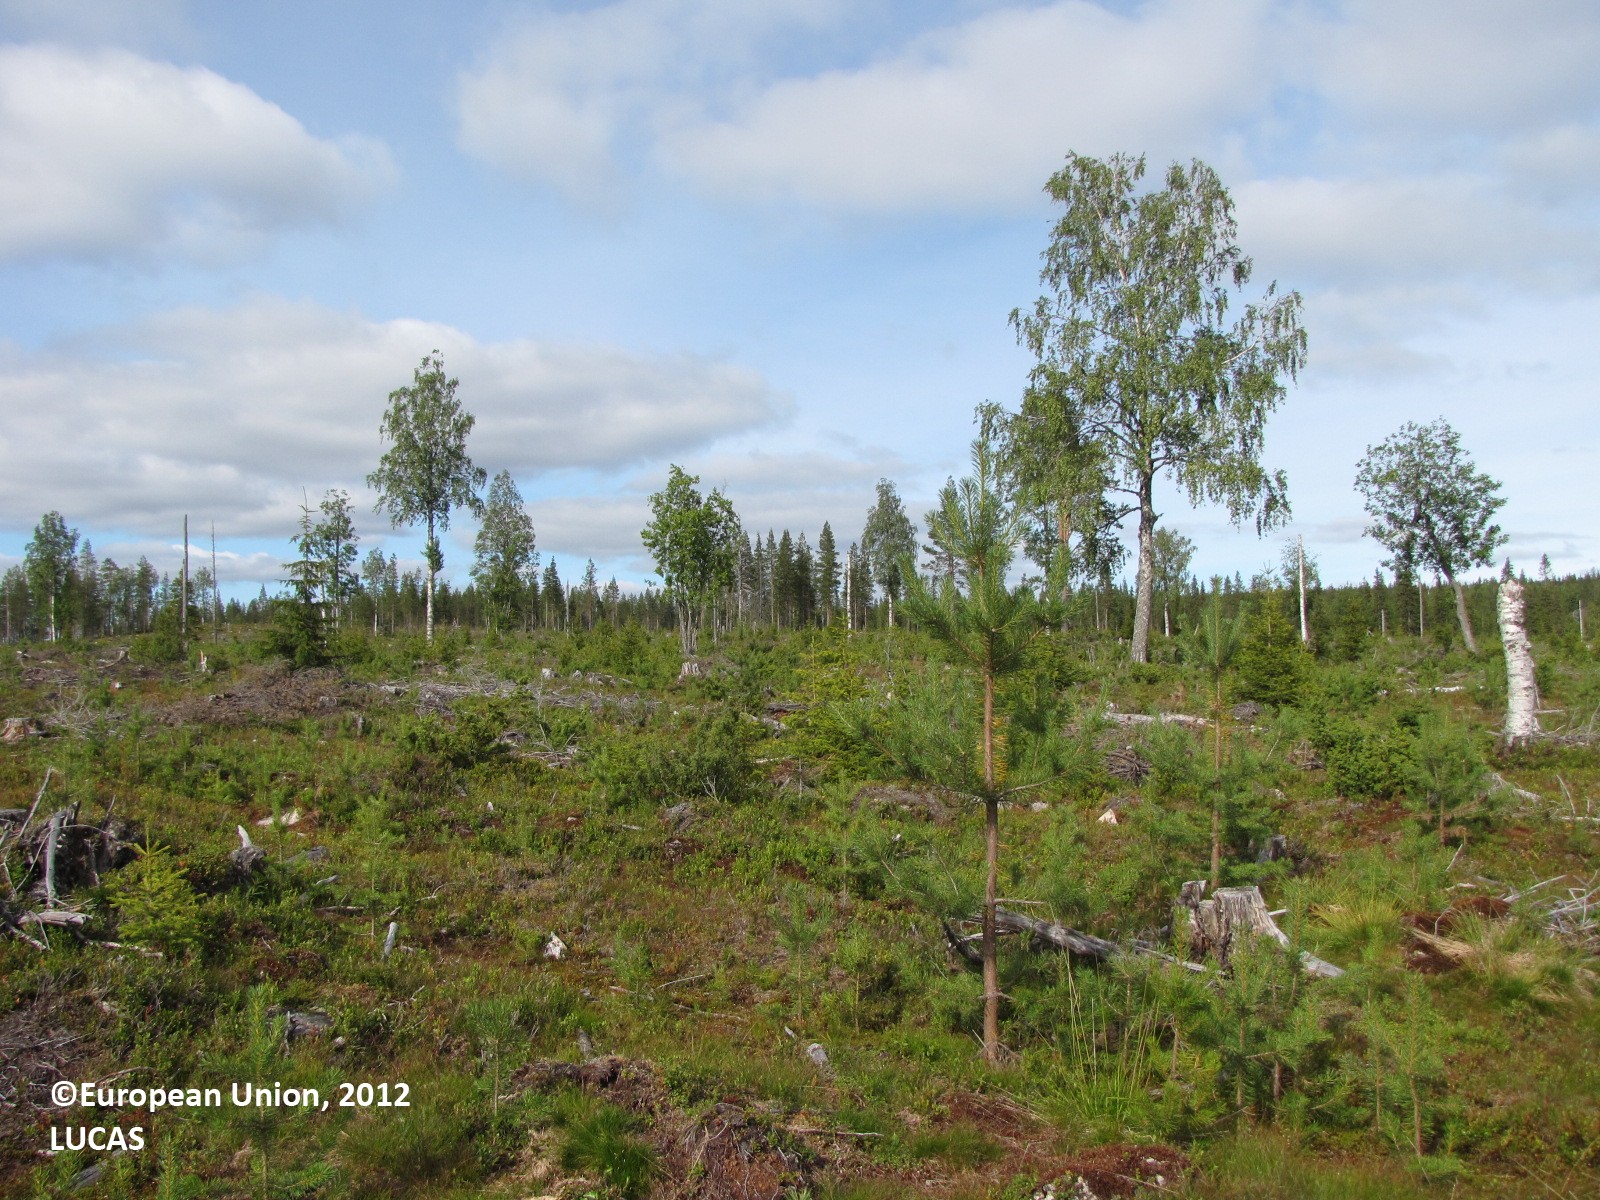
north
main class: Woodland
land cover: Pine dominated mixed woodland
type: boreal forest
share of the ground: 10 - 25 %
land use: Forestry
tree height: < 5 m
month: August
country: FI
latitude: 66.9266
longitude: 24.6526
